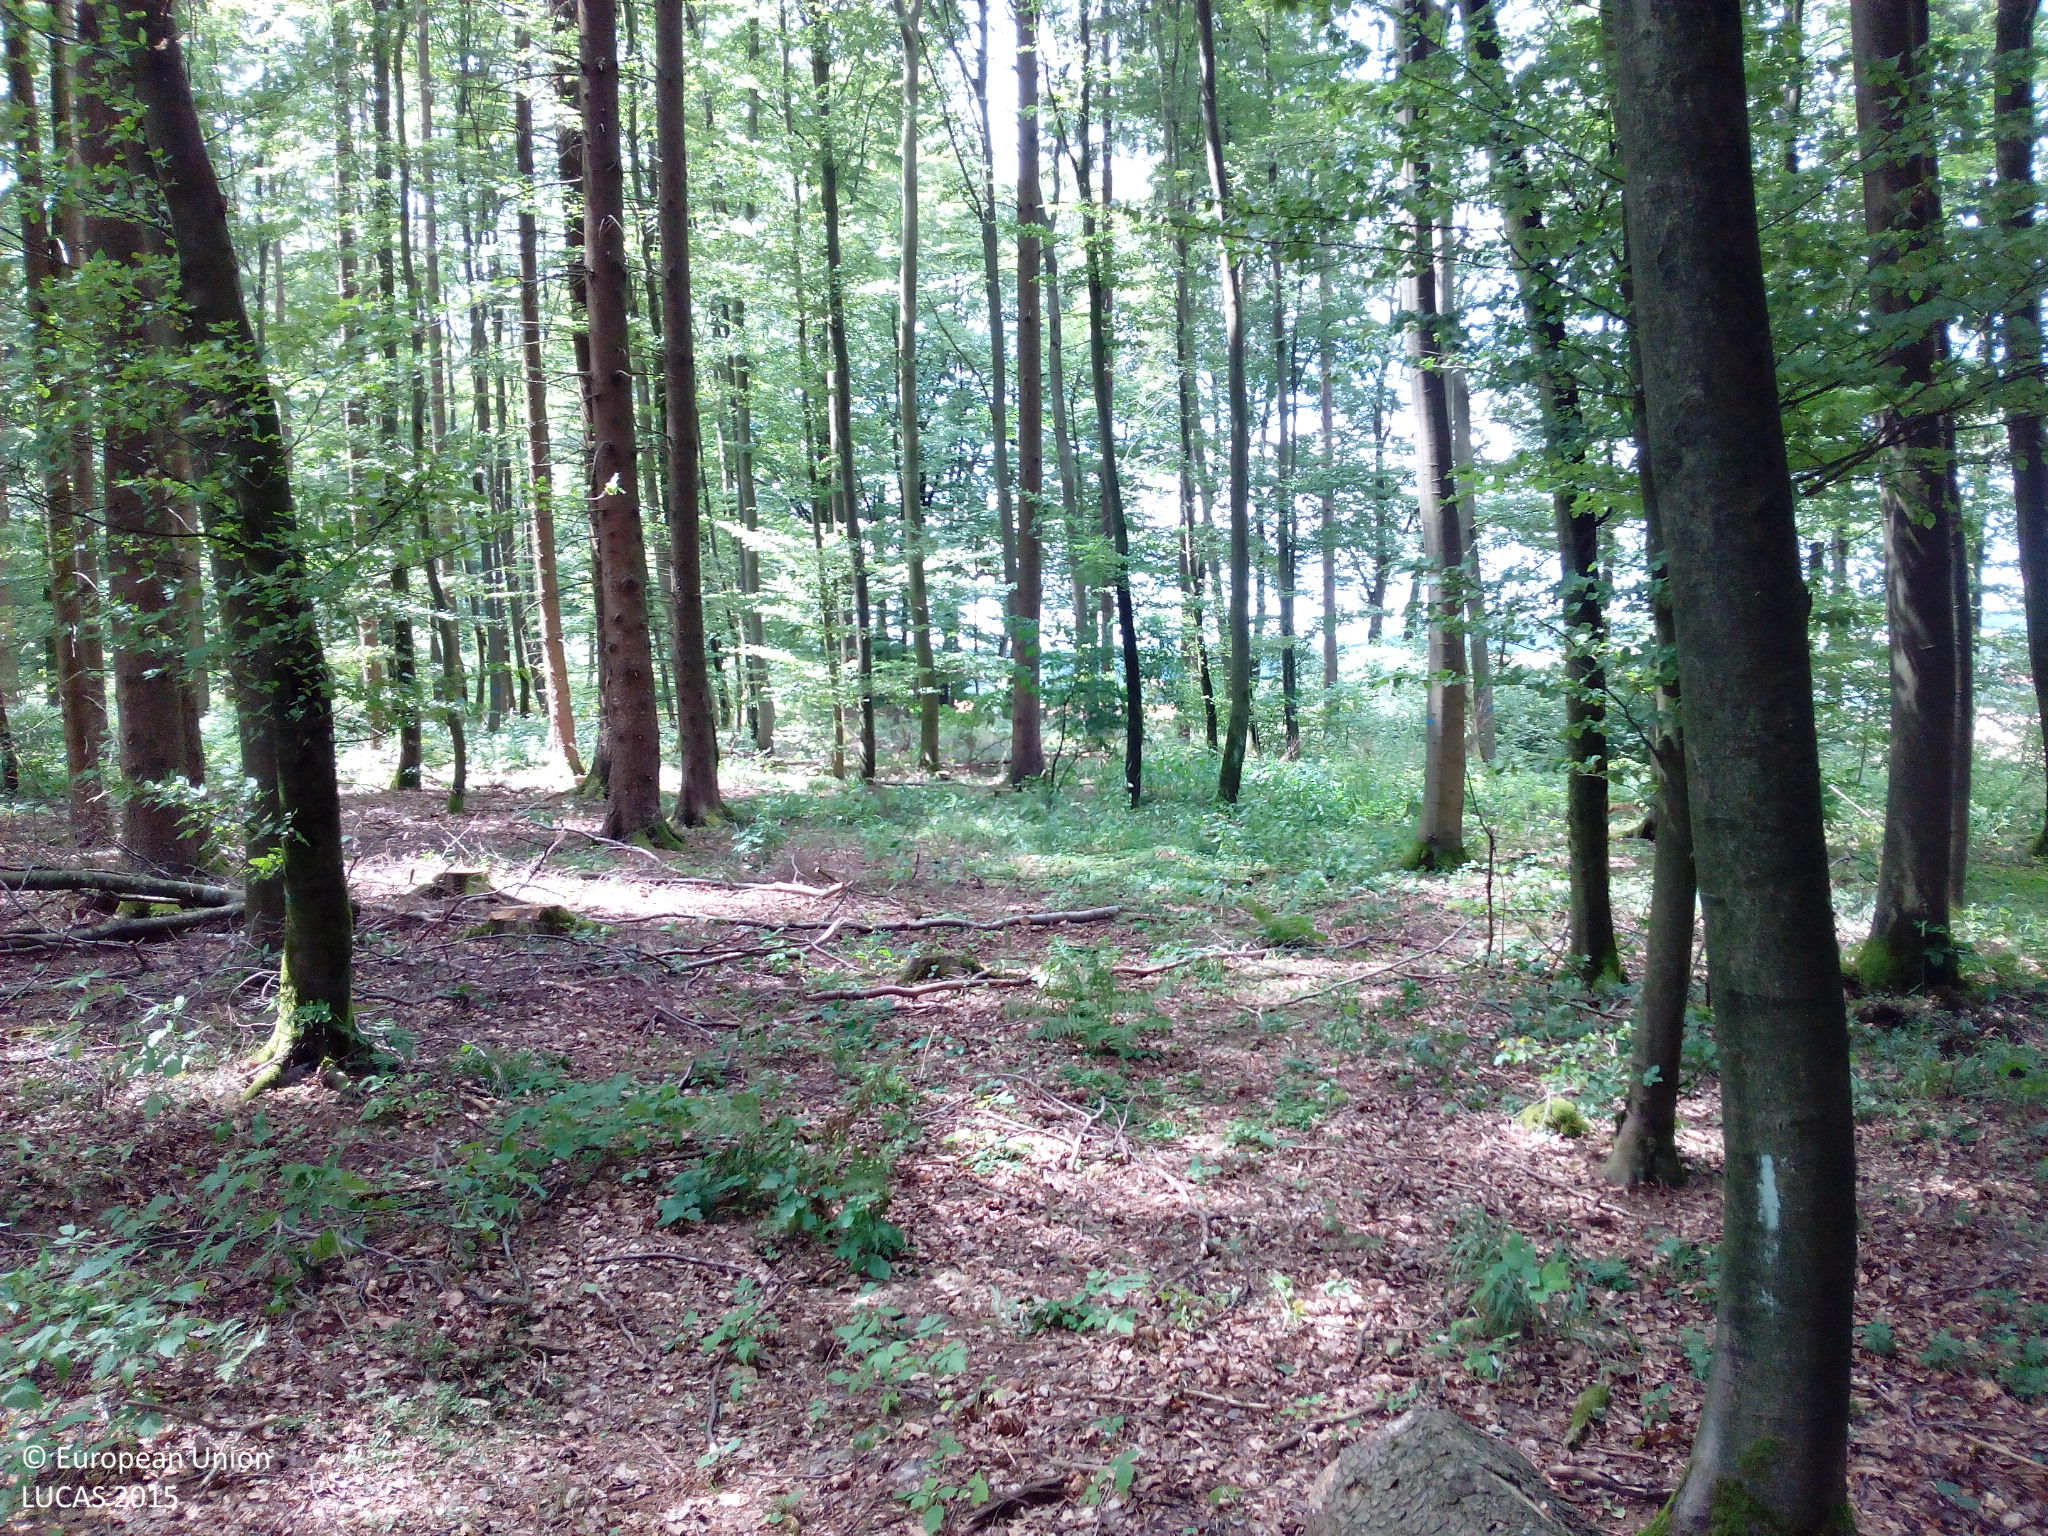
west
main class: Woodland
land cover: Spruce dominated mixed woodland
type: hemiboreal forest and nemoral coniferous forest and mixed broadleaved-coniferous forest
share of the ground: > 75 %
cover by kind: broadleaved forest trees 40 %, coniferous forest trees 35 %, unconsolidated bare surface 20 %, herbaceous plants 5 %
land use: Forestry
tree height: > 5 m
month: July
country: DE
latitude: 48.8170
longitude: 10.2586
